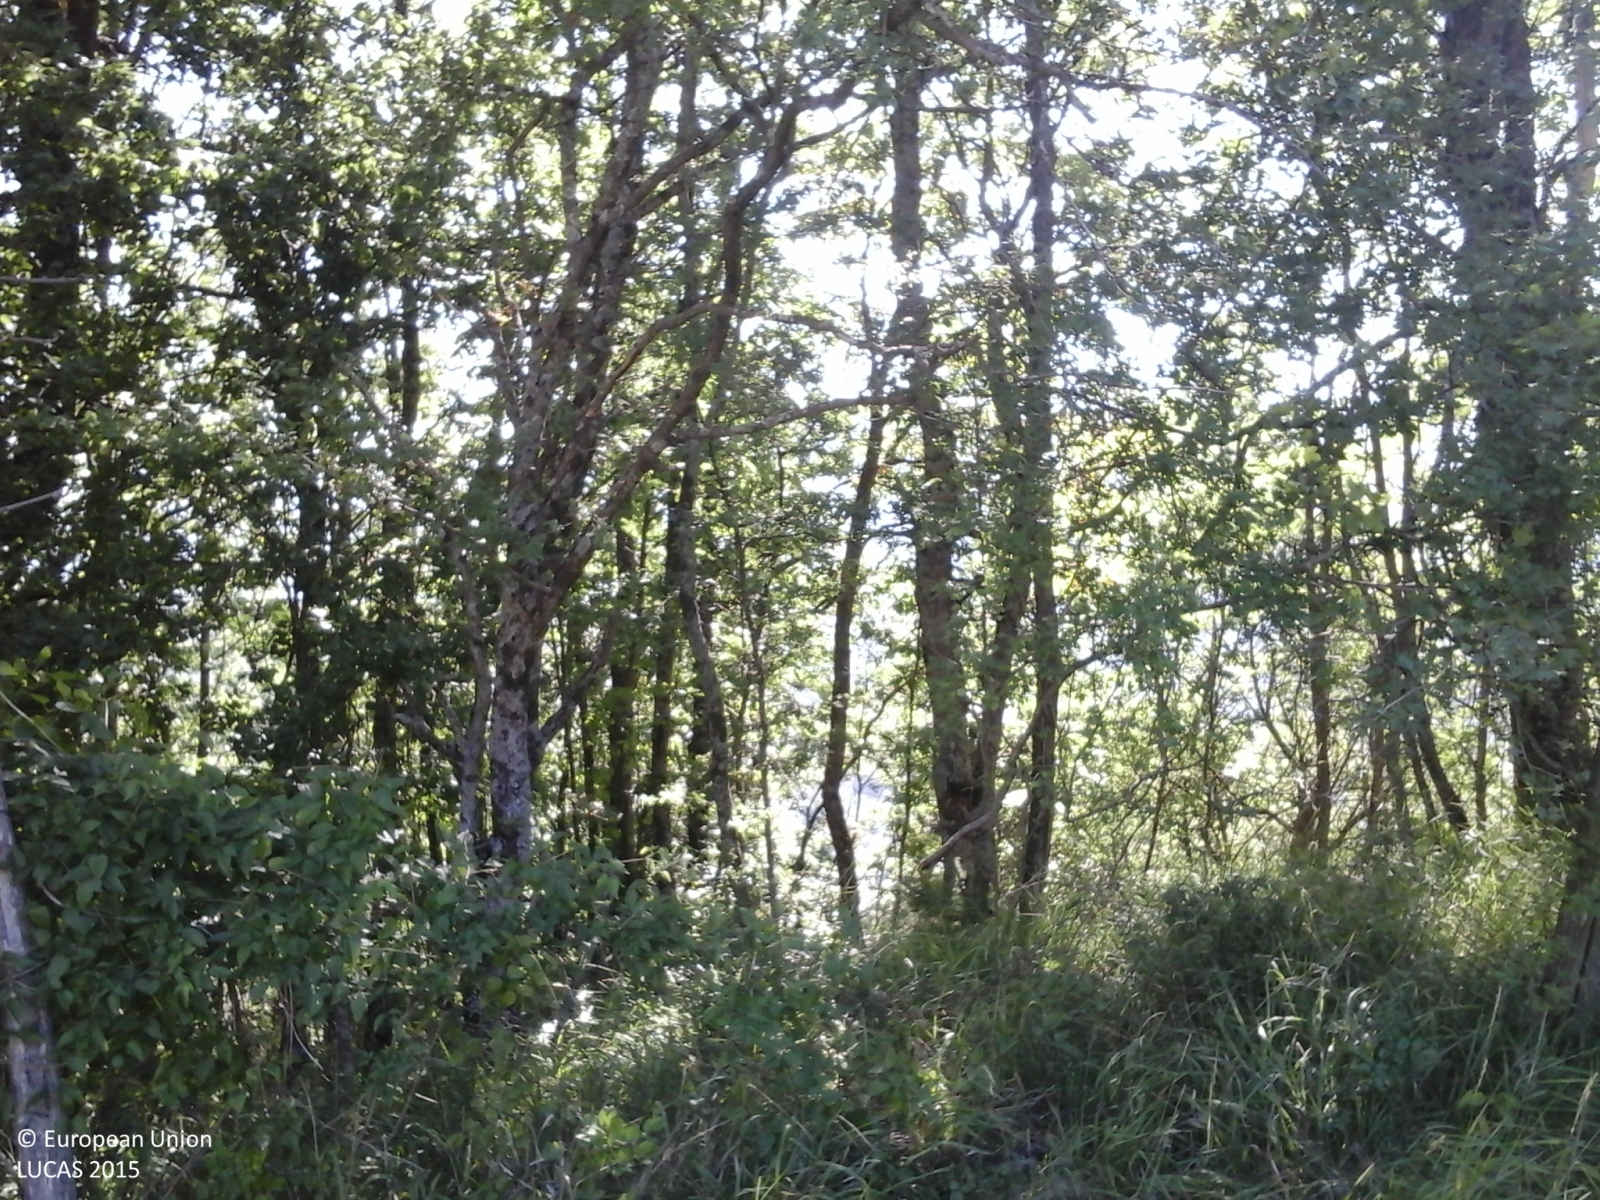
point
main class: Woodland
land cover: Broadleaved woodland
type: thermophilous deciduous forest
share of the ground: > 75 %
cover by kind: broadleaved forest trees 100 %
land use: Forestry
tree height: > 5 m
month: July
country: IT
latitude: 44.2404
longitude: 10.6371
